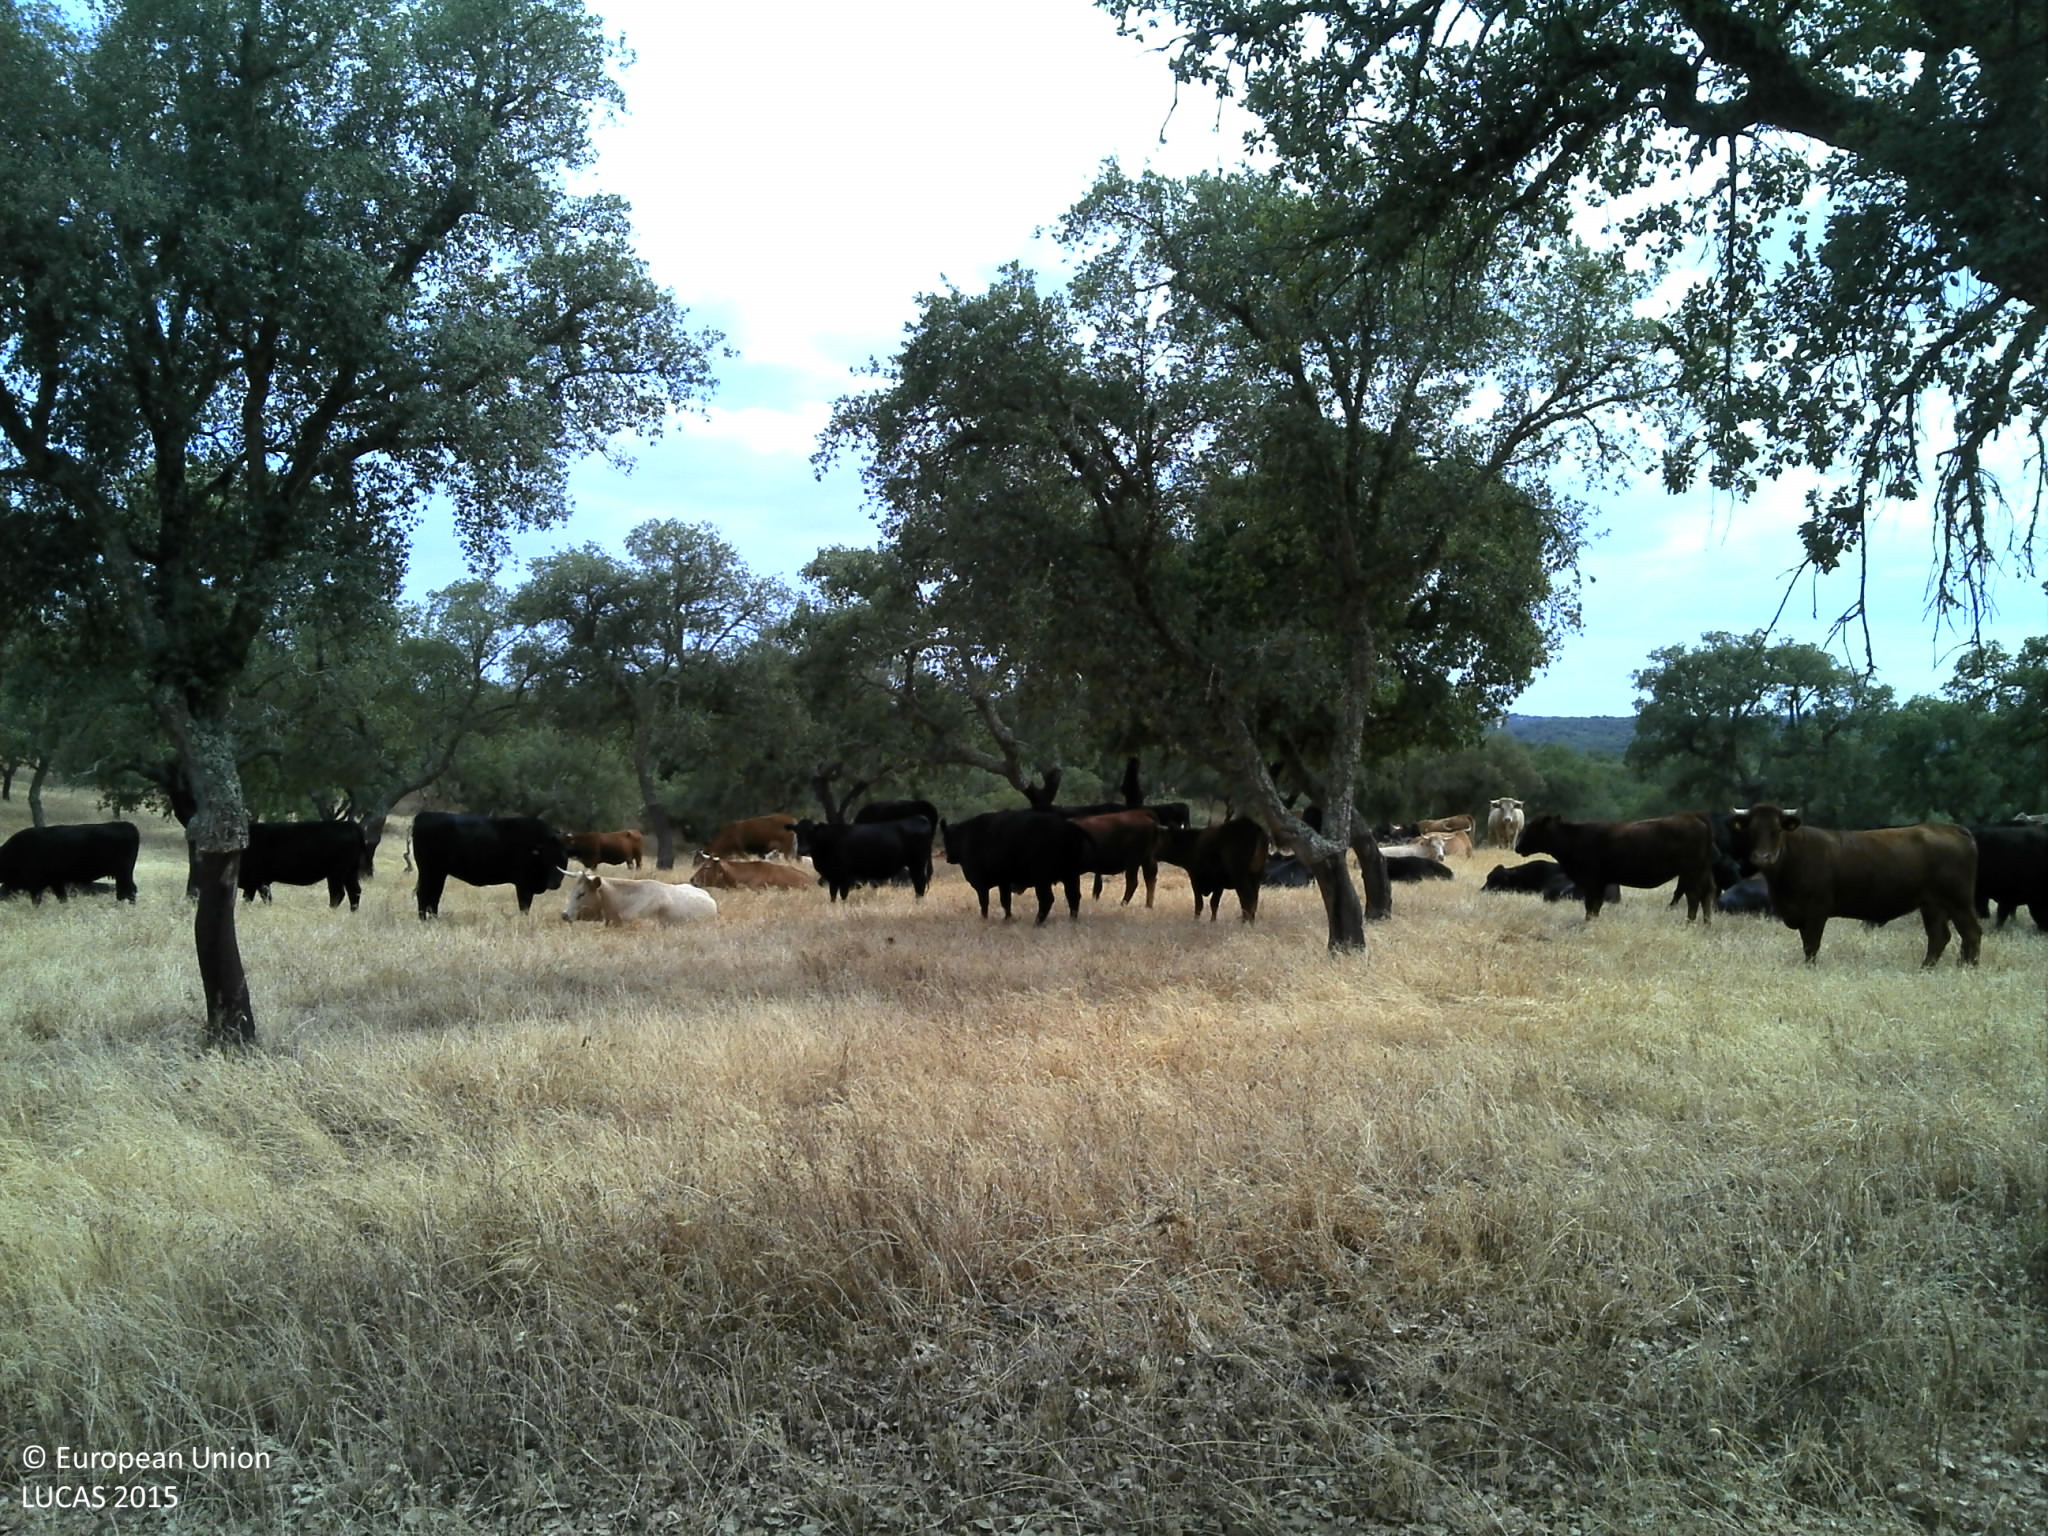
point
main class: Woodland
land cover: Broadleaved woodland
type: broadleaved evergreen forest
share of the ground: 25 - 50 %
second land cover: Spontaneously vegetated surfaces
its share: 50 - 75 %
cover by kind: herbaceous plants 60 %, broadleaved forest trees 25 %, unconsolidated bare surface 15 %
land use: Forestry
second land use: Agriculture (excluding fallow land and kitchen gardens)
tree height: > 5 m
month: June
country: PT
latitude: 38.3998
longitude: -7.8167
